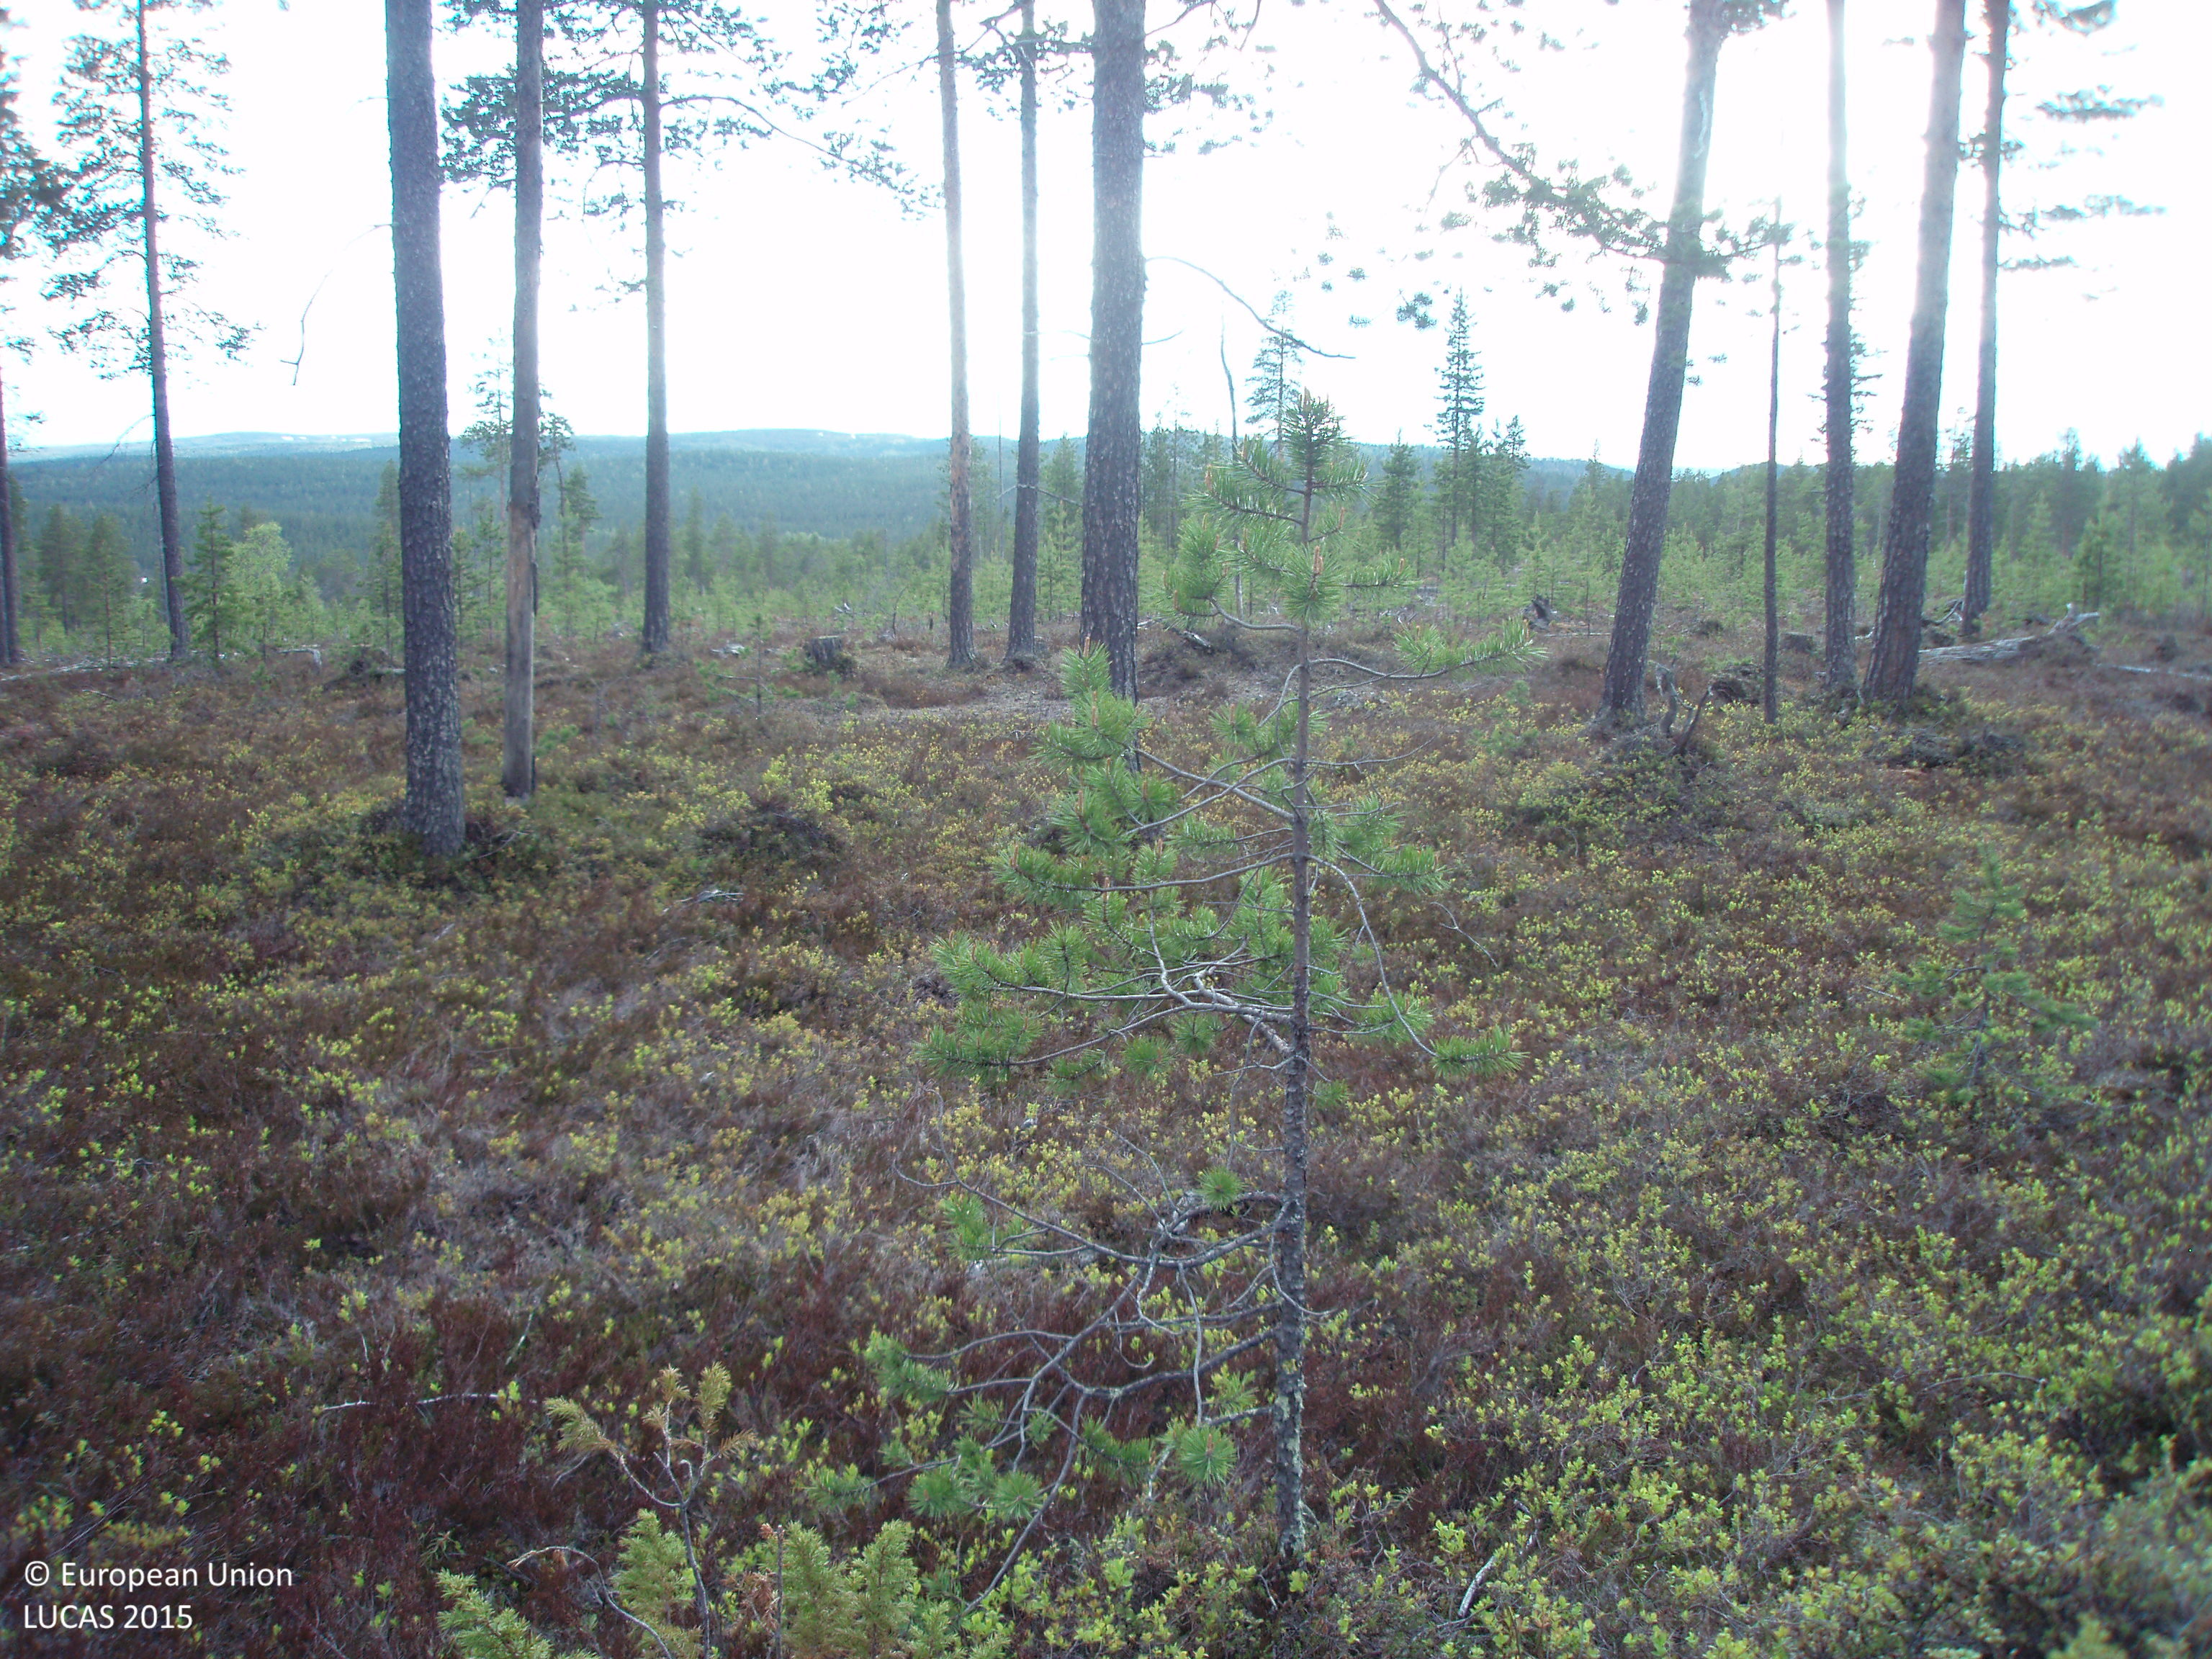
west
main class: Woodland
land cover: Pine dominated coniferous woodland
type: boreal forest
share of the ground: 25 - 50 %
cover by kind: shrubs 70 %, coniferous forest trees 25 %, lichens and mosses 5 %
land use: Forestry
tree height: > 5 m
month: June
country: FI
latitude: 68.4356
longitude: 27.8644
